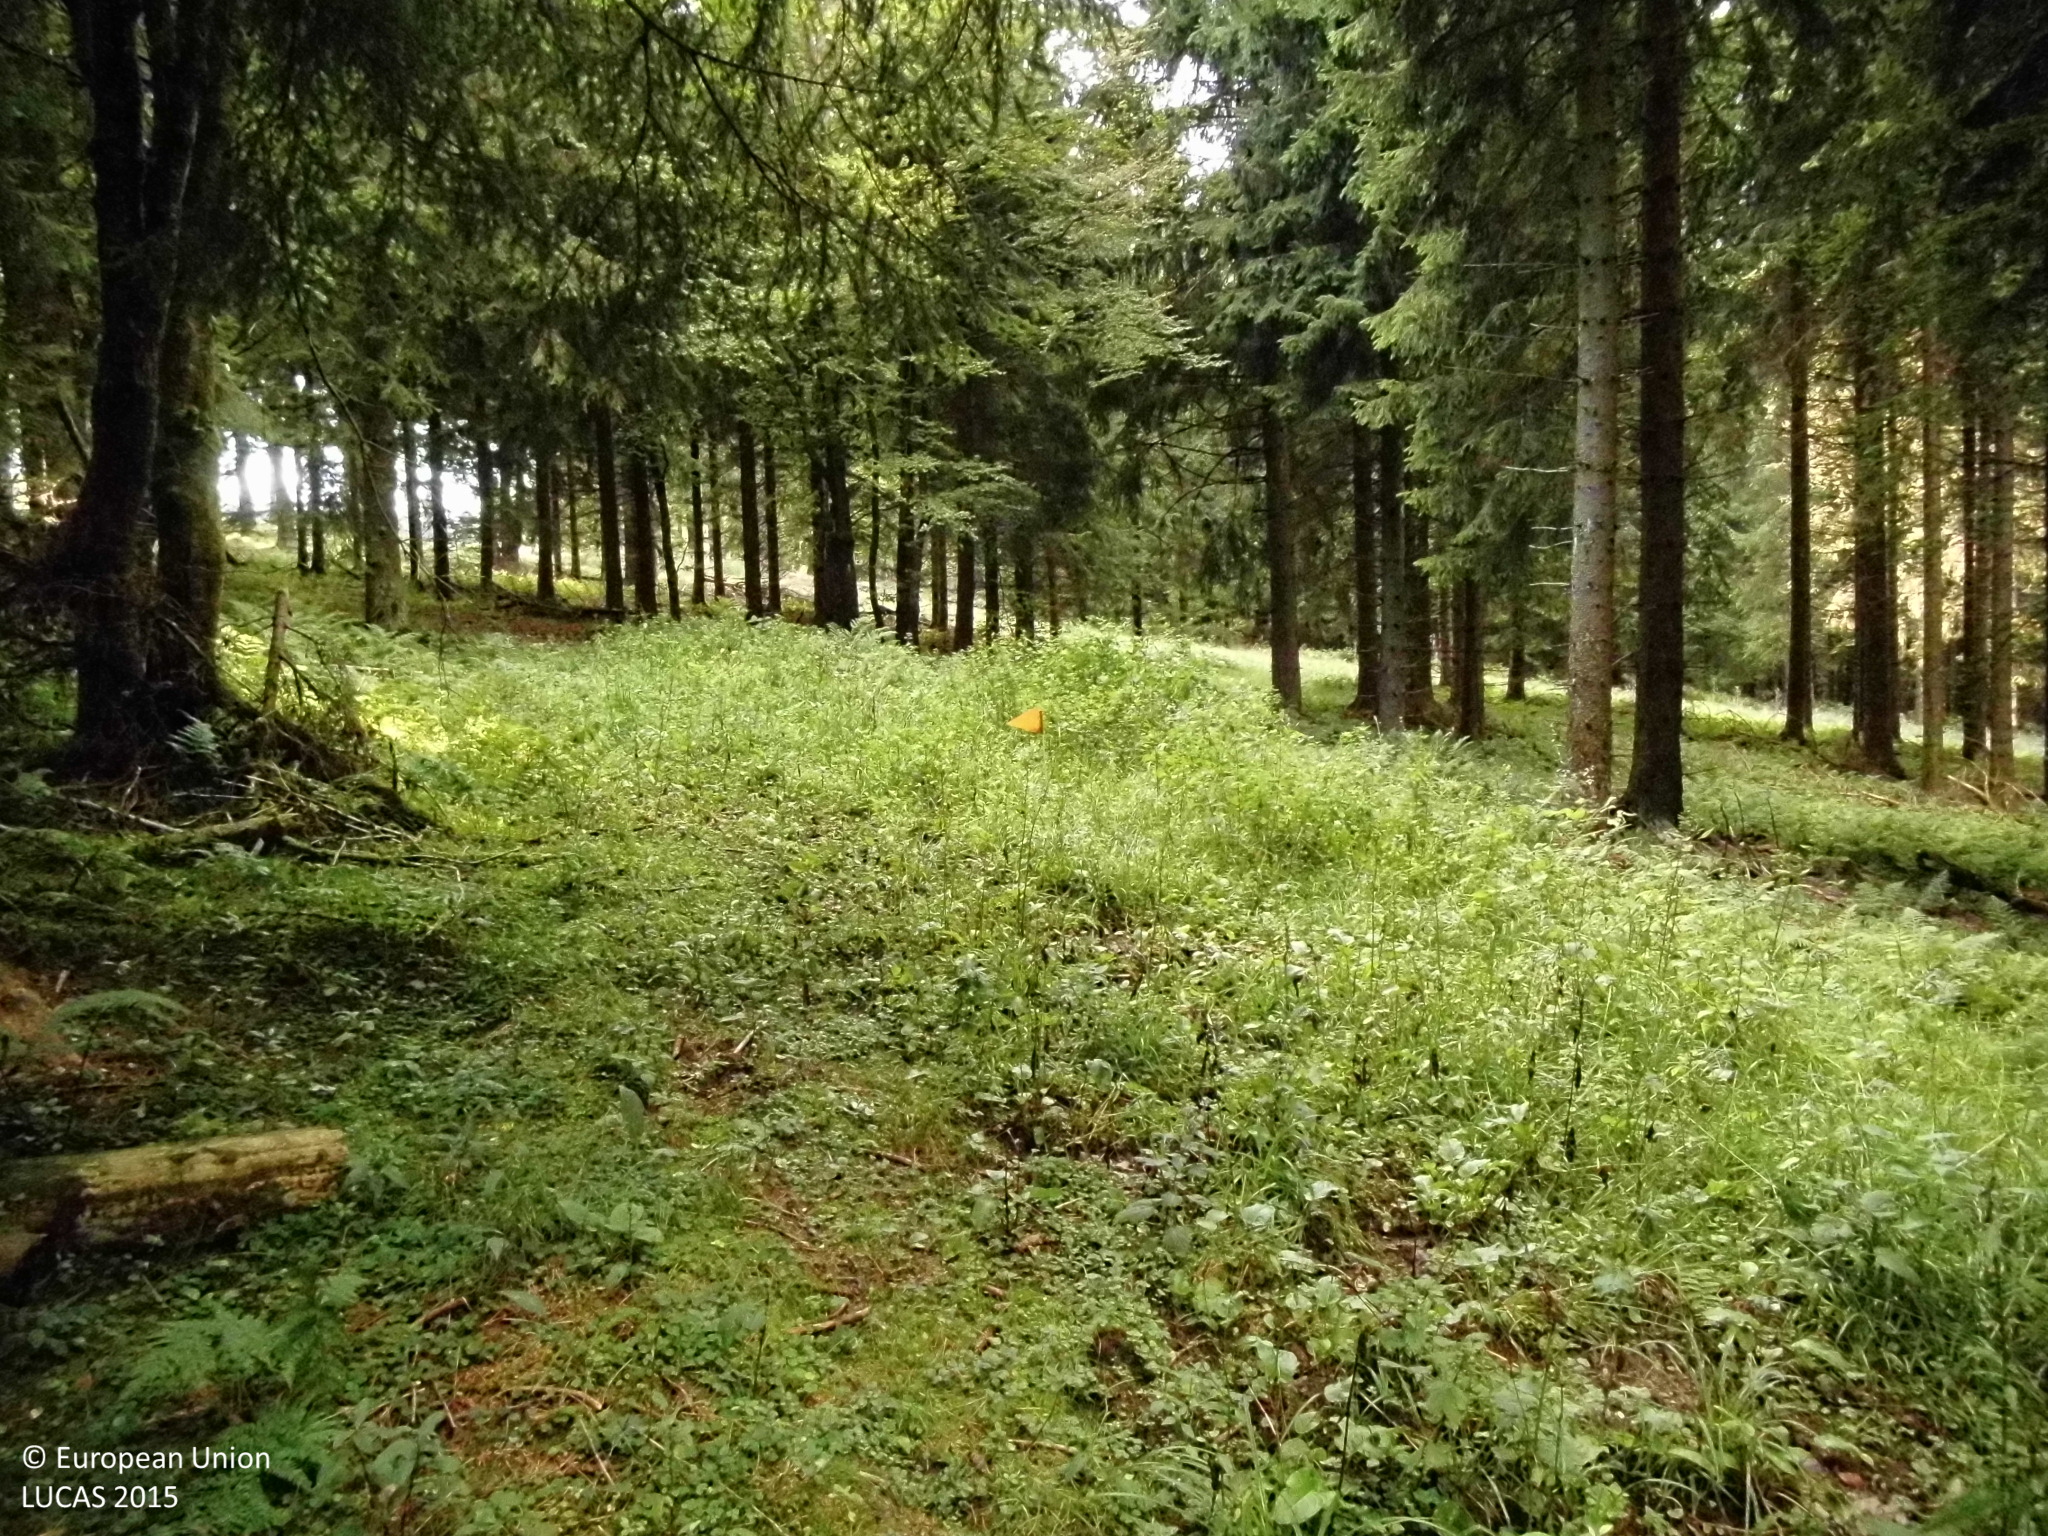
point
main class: Artificial land
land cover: Non built-up linear features
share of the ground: > 75 %
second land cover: Grassland without tree/shrub cover
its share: > 75 %
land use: Forestry
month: September
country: DE
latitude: 51.1990
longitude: 8.4691
